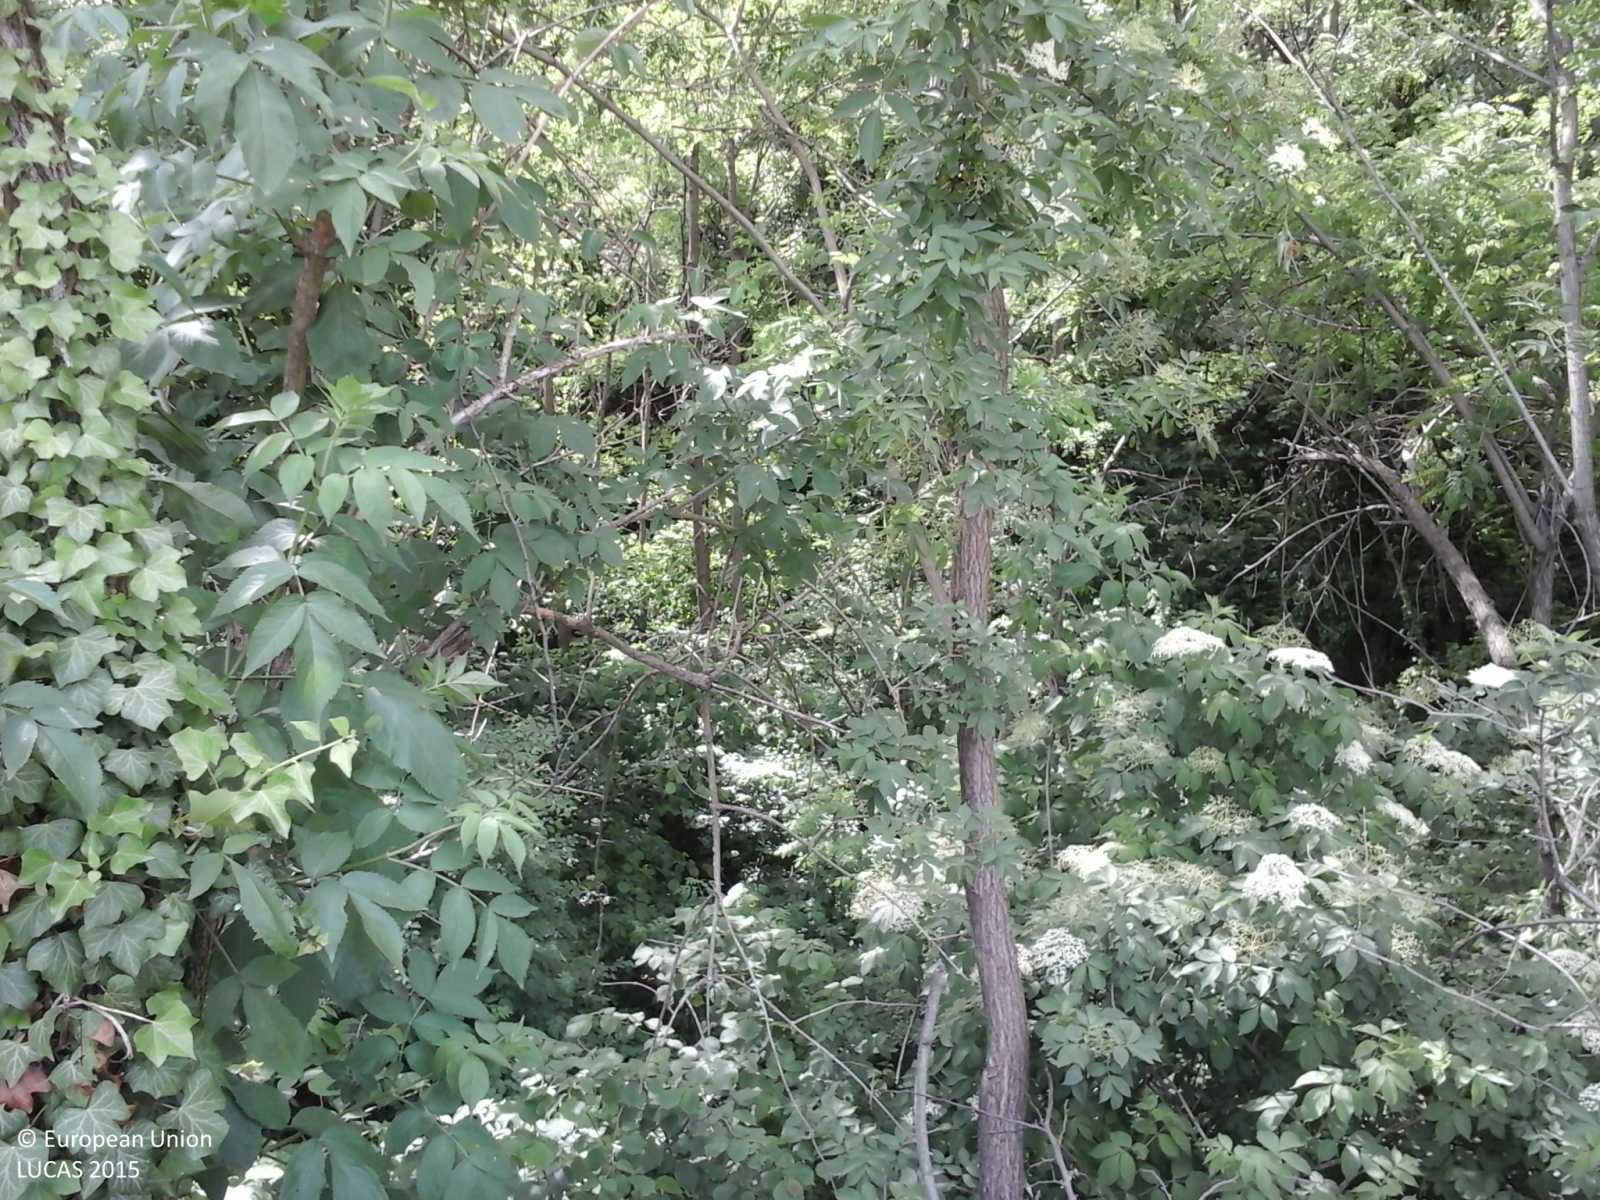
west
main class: Woodland
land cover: Broadleaved woodland
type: thermophilous deciduous forest
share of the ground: > 75 %
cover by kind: broadleaved forest trees 100 %
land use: Semi-natural and natural areas not in use
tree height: > 5 m
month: May
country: IT
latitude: 44.4722
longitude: 7.8298
